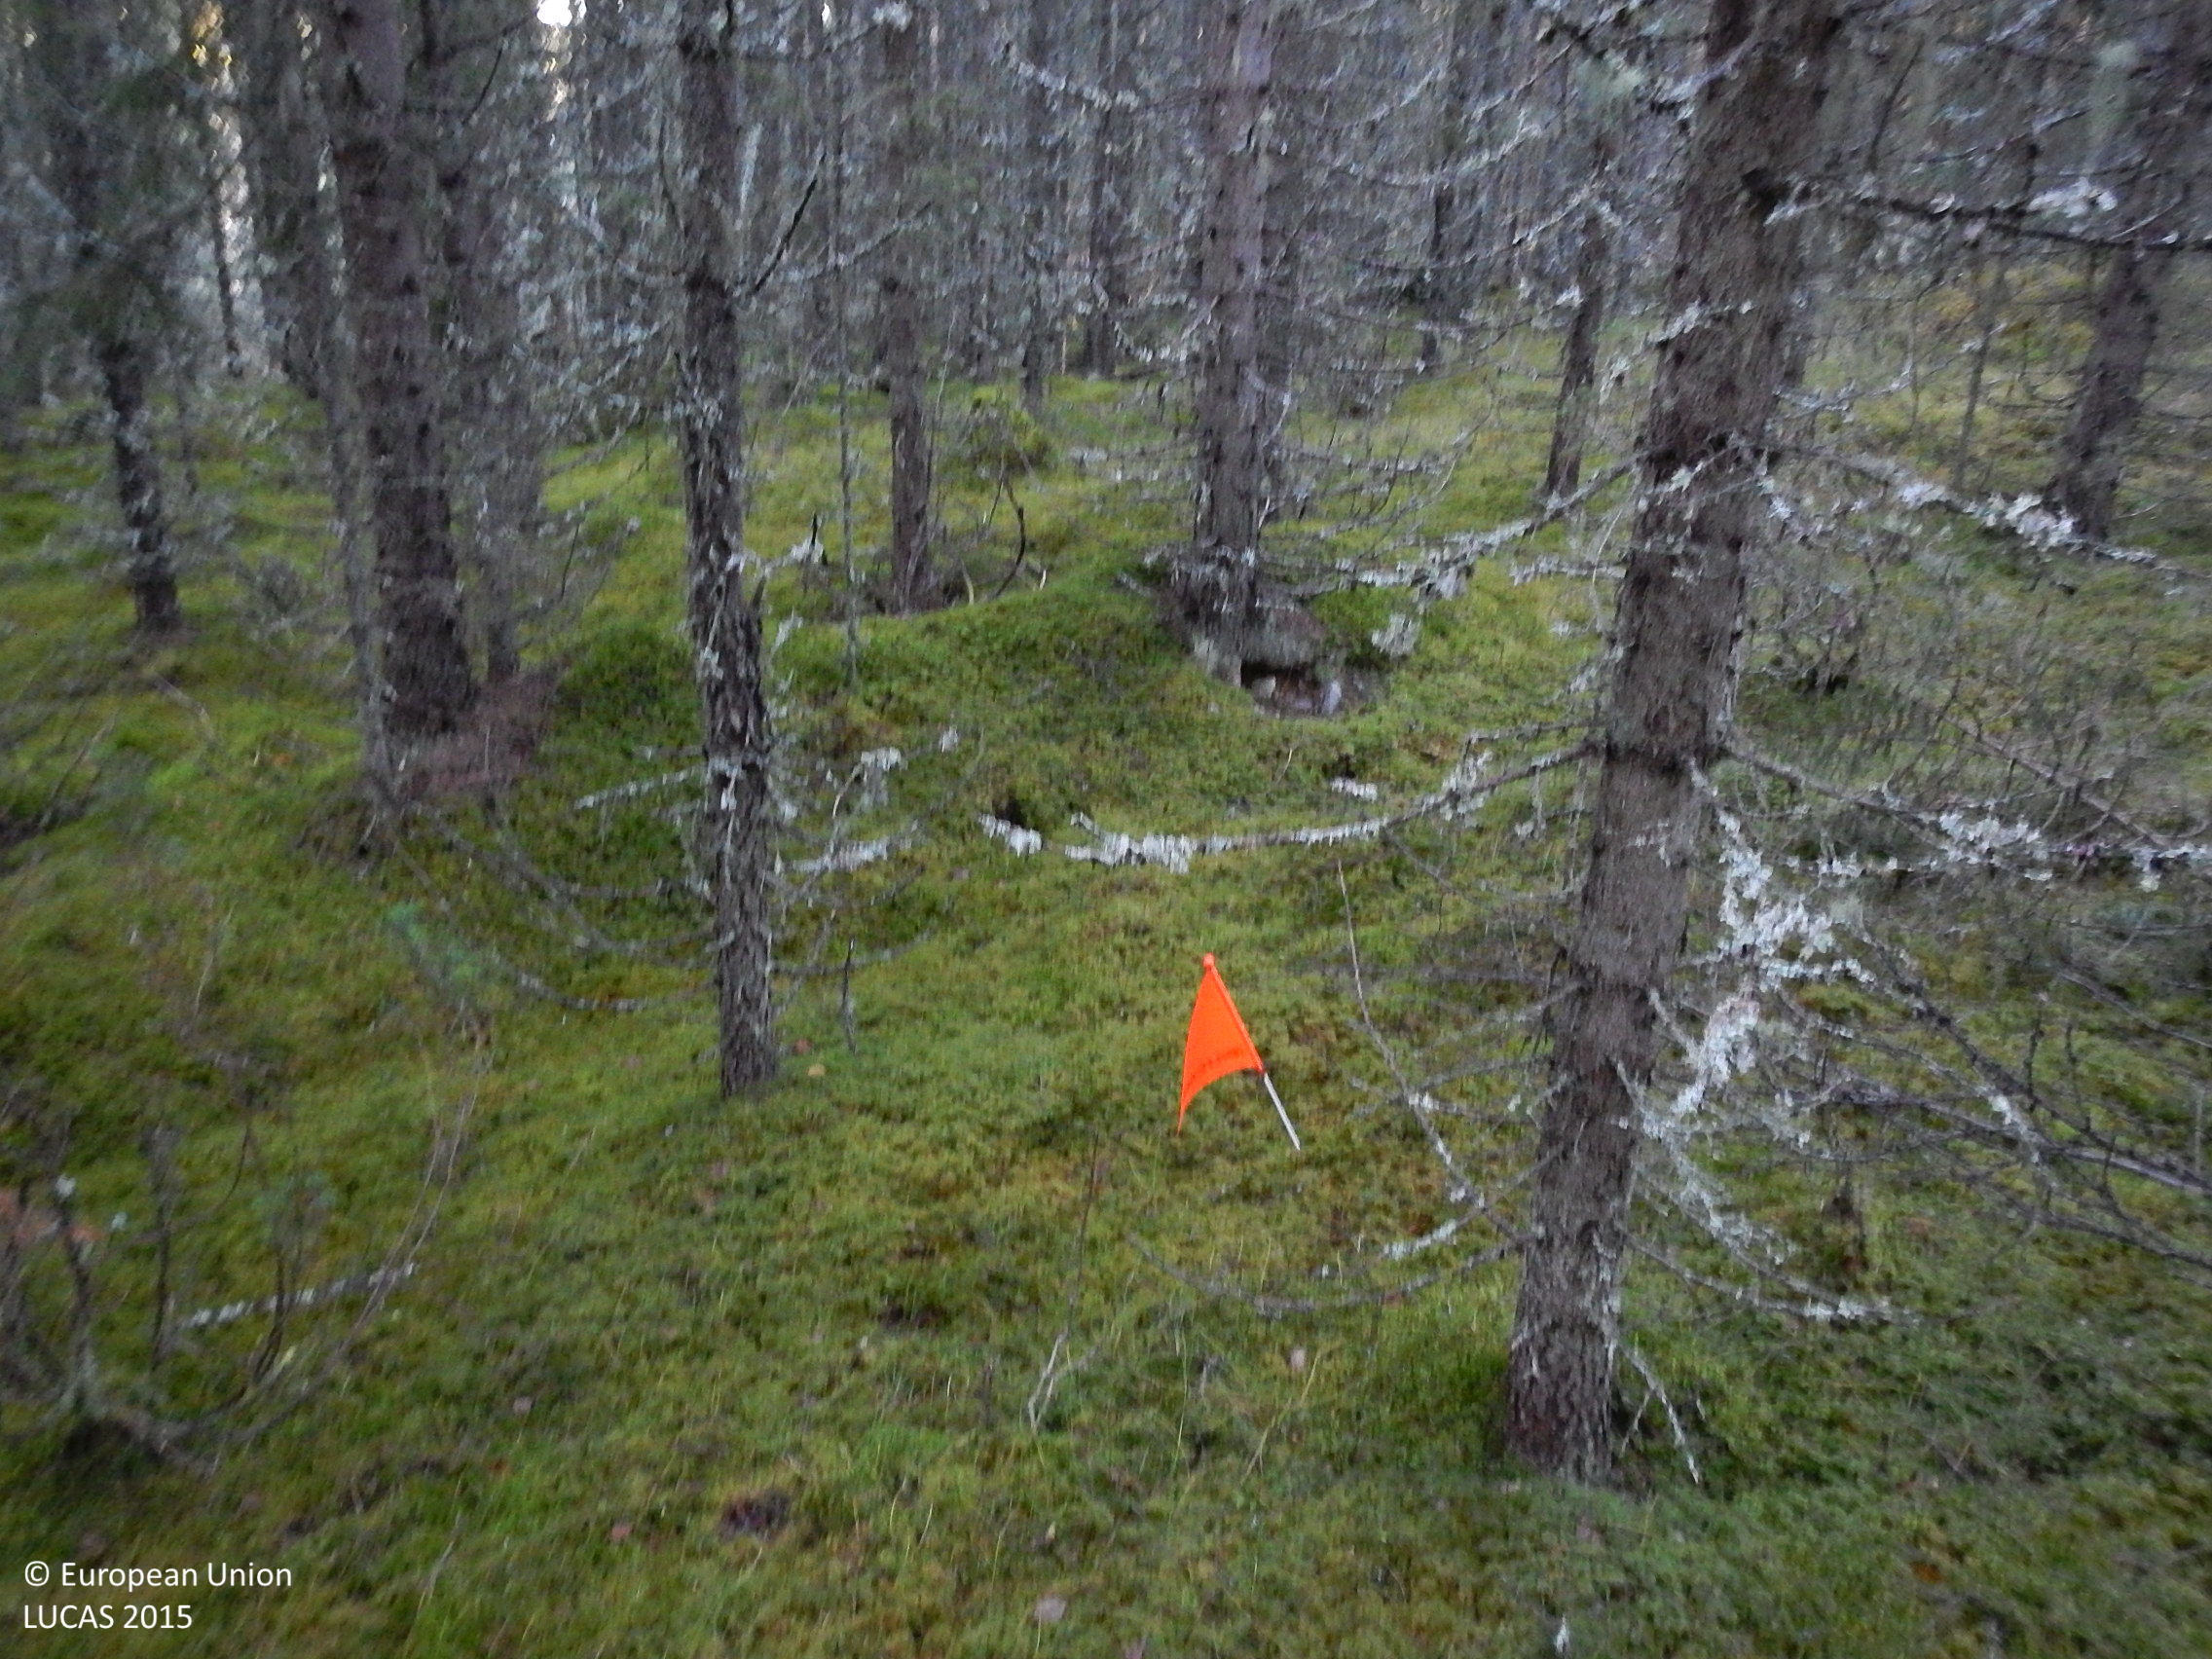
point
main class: Woodland
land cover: Spruce dominated coniferous woodland
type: boreal forest
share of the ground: > 75 %
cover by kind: coniferous forest trees 90 %, lichens and mosses 10 %
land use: Forestry
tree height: > 5 m
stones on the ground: < 10 %
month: November
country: SE
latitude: 61.5155
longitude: 15.5663
